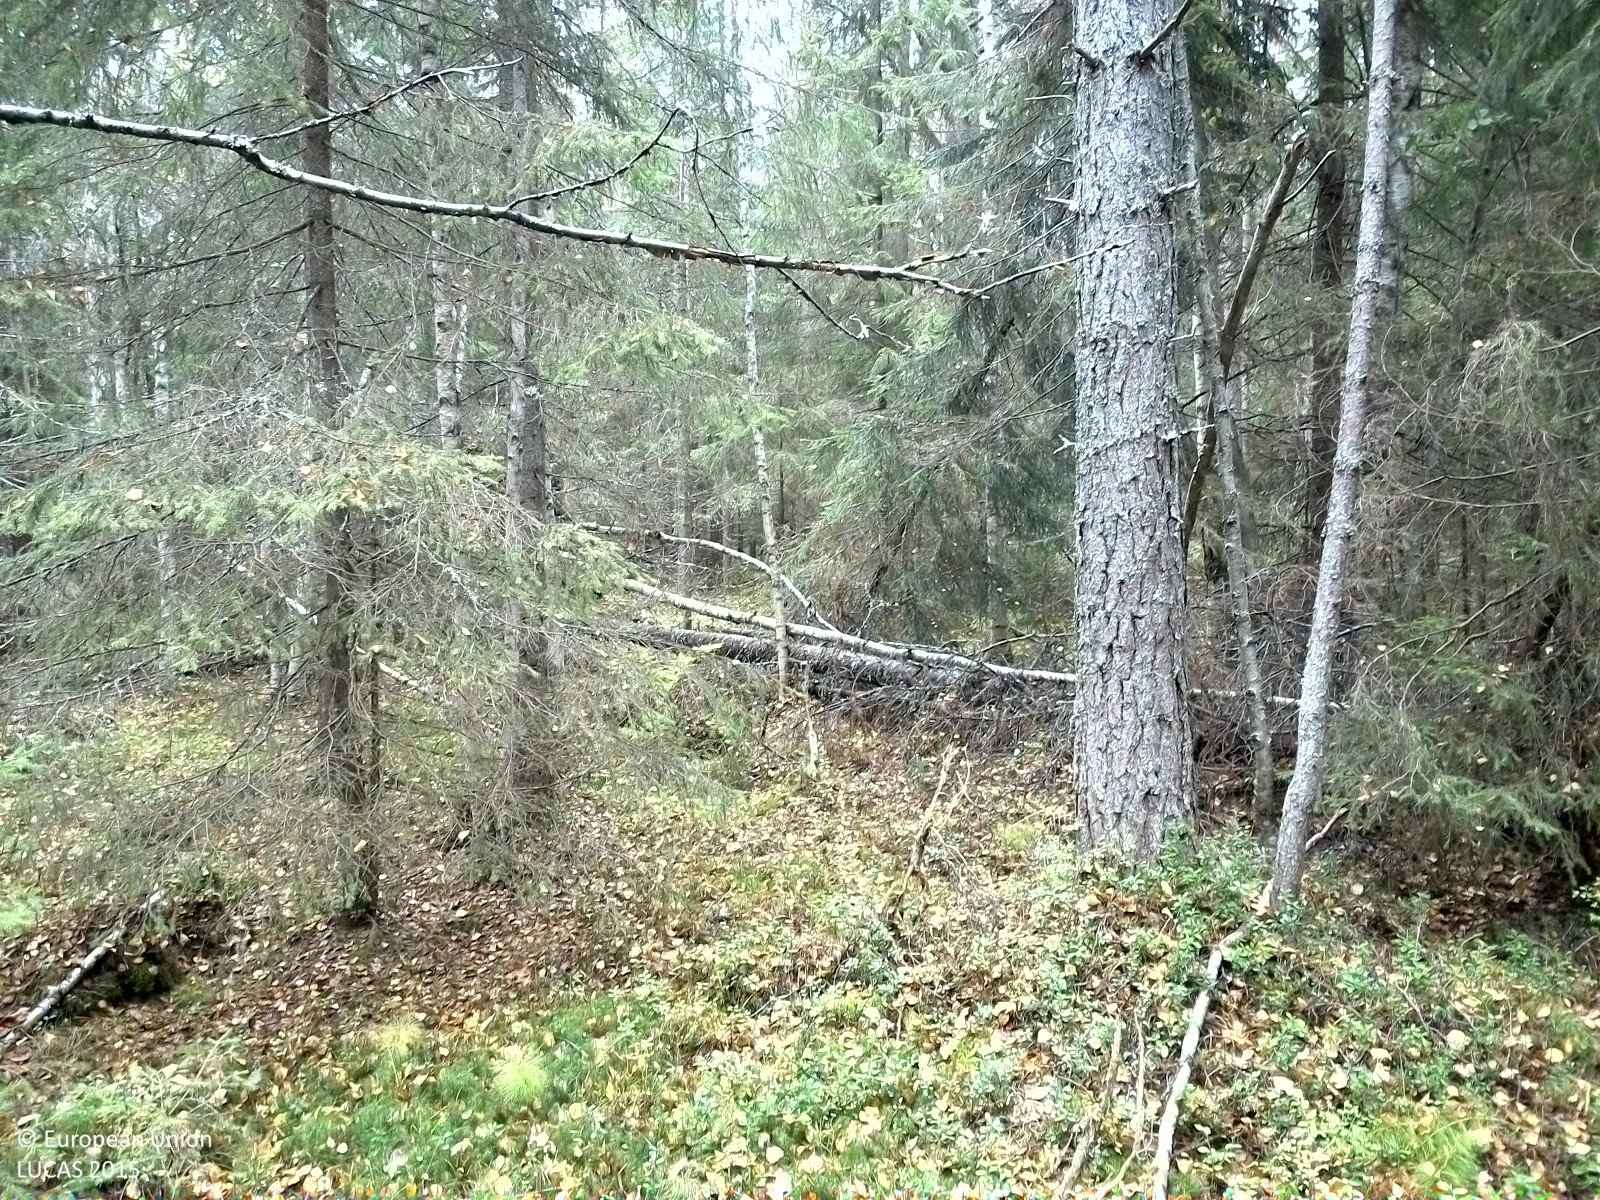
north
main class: Woodland
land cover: Other mixed woodland
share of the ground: > 75 %
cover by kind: coniferous forest trees 50 %, broadleaved forest trees 20 %, lichens and mosses 20 %, shrubs 10 %
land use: Forestry
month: October
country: SE
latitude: 62.5321
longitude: 17.5397
